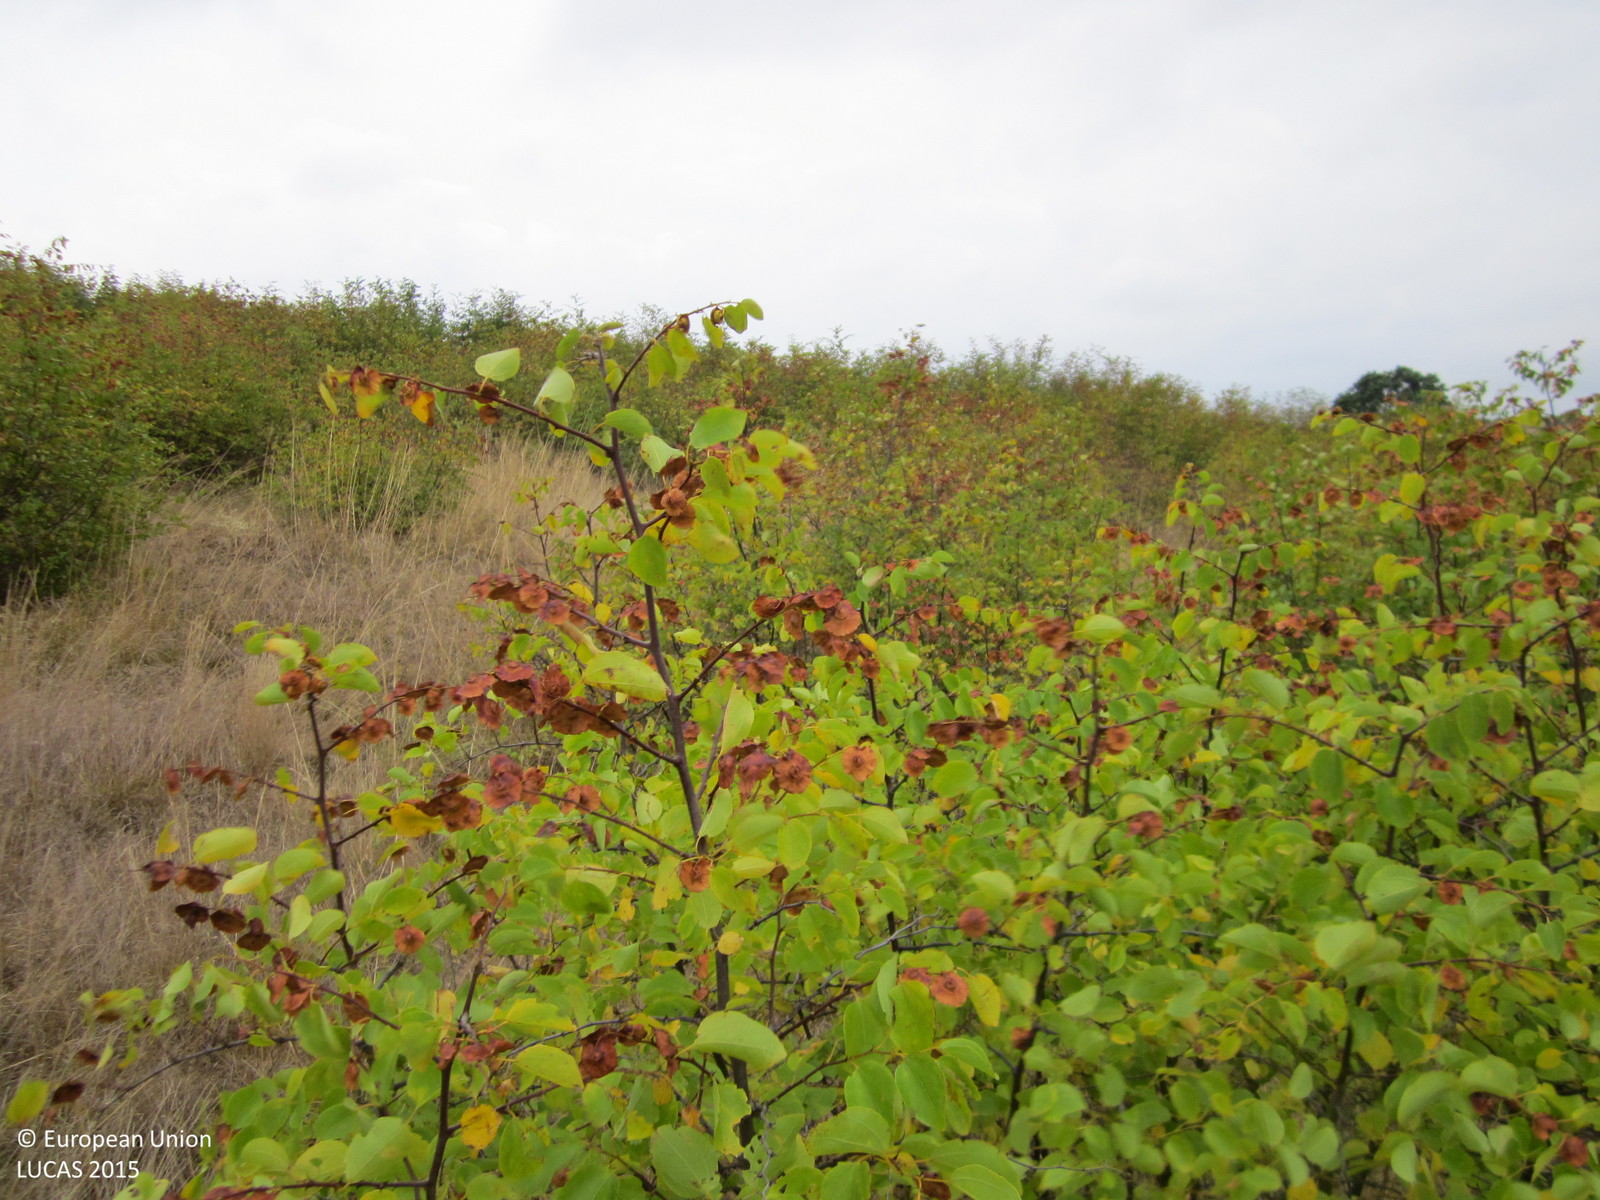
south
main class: Shrubland
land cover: Shrubland without tree cover
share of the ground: 50 - 75 %
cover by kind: shrubs 60 %, herbaceous plants 40 %
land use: Semi-natural and natural areas not in use
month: August
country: BG
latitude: 42.5237
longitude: 27.0388
